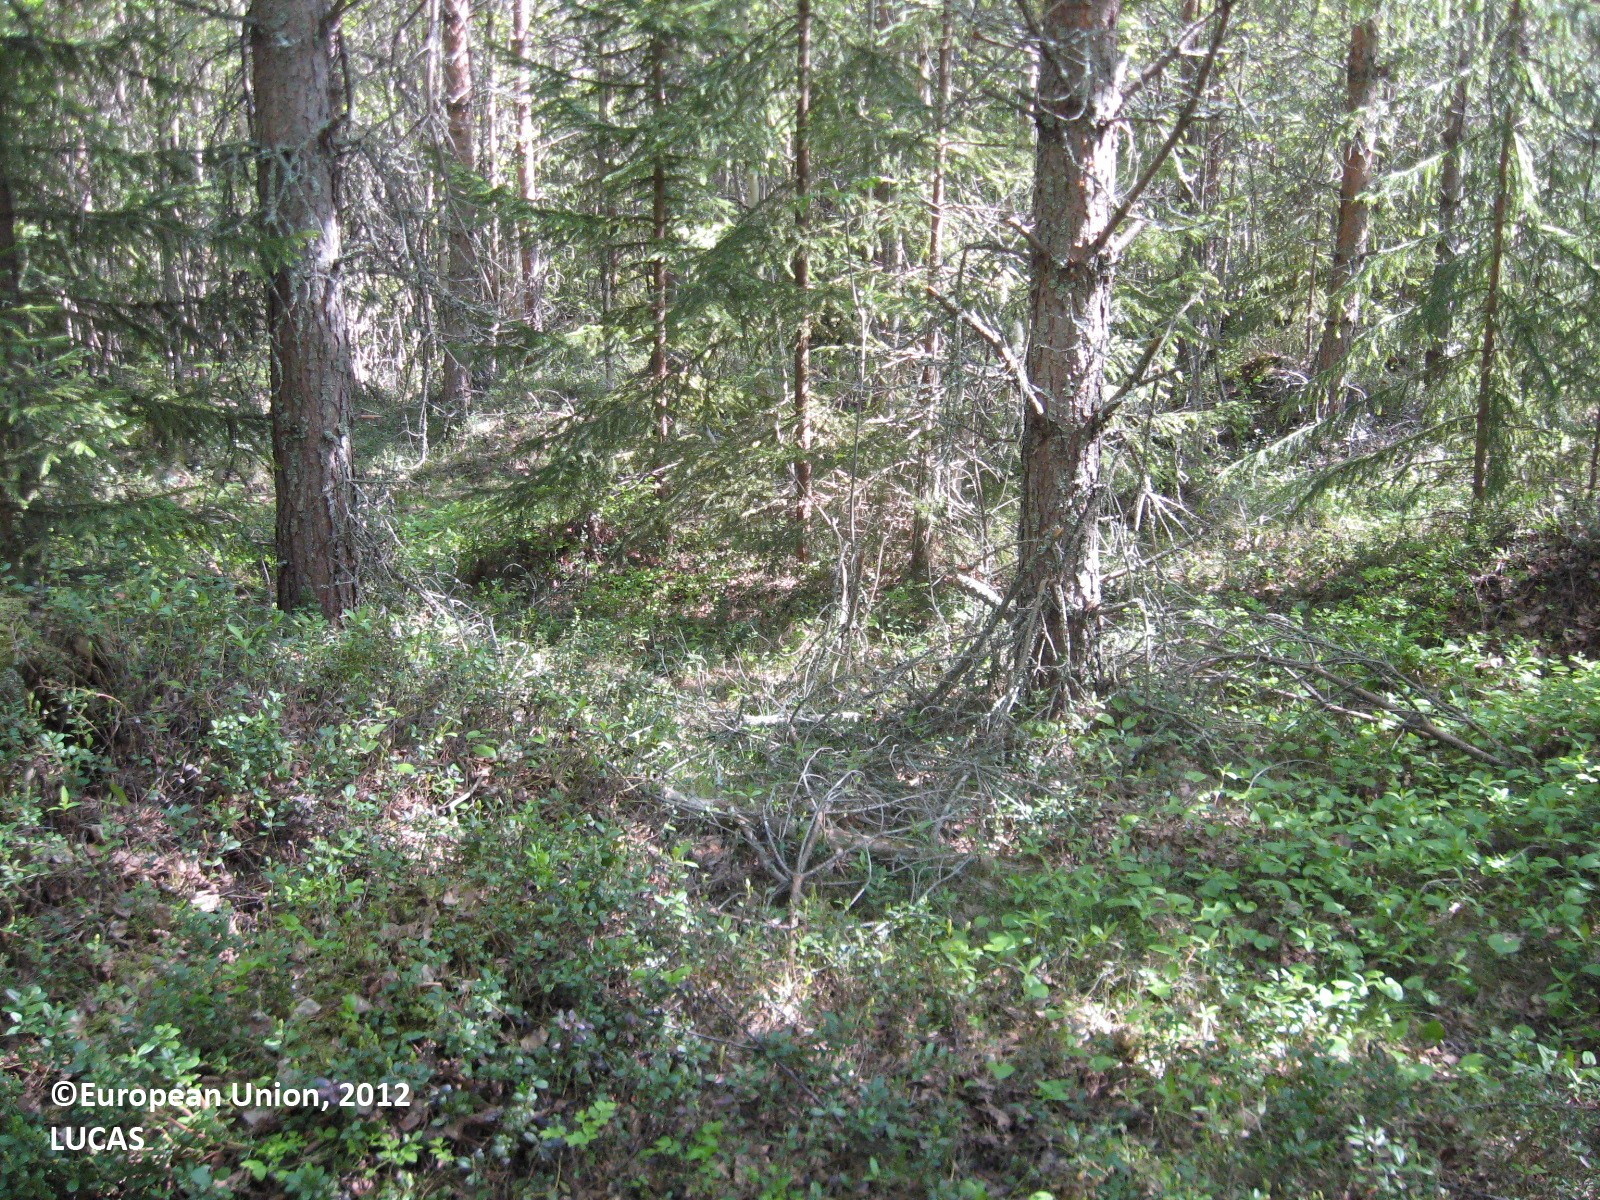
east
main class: Woodland
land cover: Pine dominated mixed woodland
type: boreal forest
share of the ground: > 75 %
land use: Forestry
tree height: > 5 m
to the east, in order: Pine dominated mixed woodland; Other mixed woodland; Broadleaved woodland; Pine dominated mixed woodland; Pine dominated coniferous woodland
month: June
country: FI
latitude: 63.2042
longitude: 21.3496
